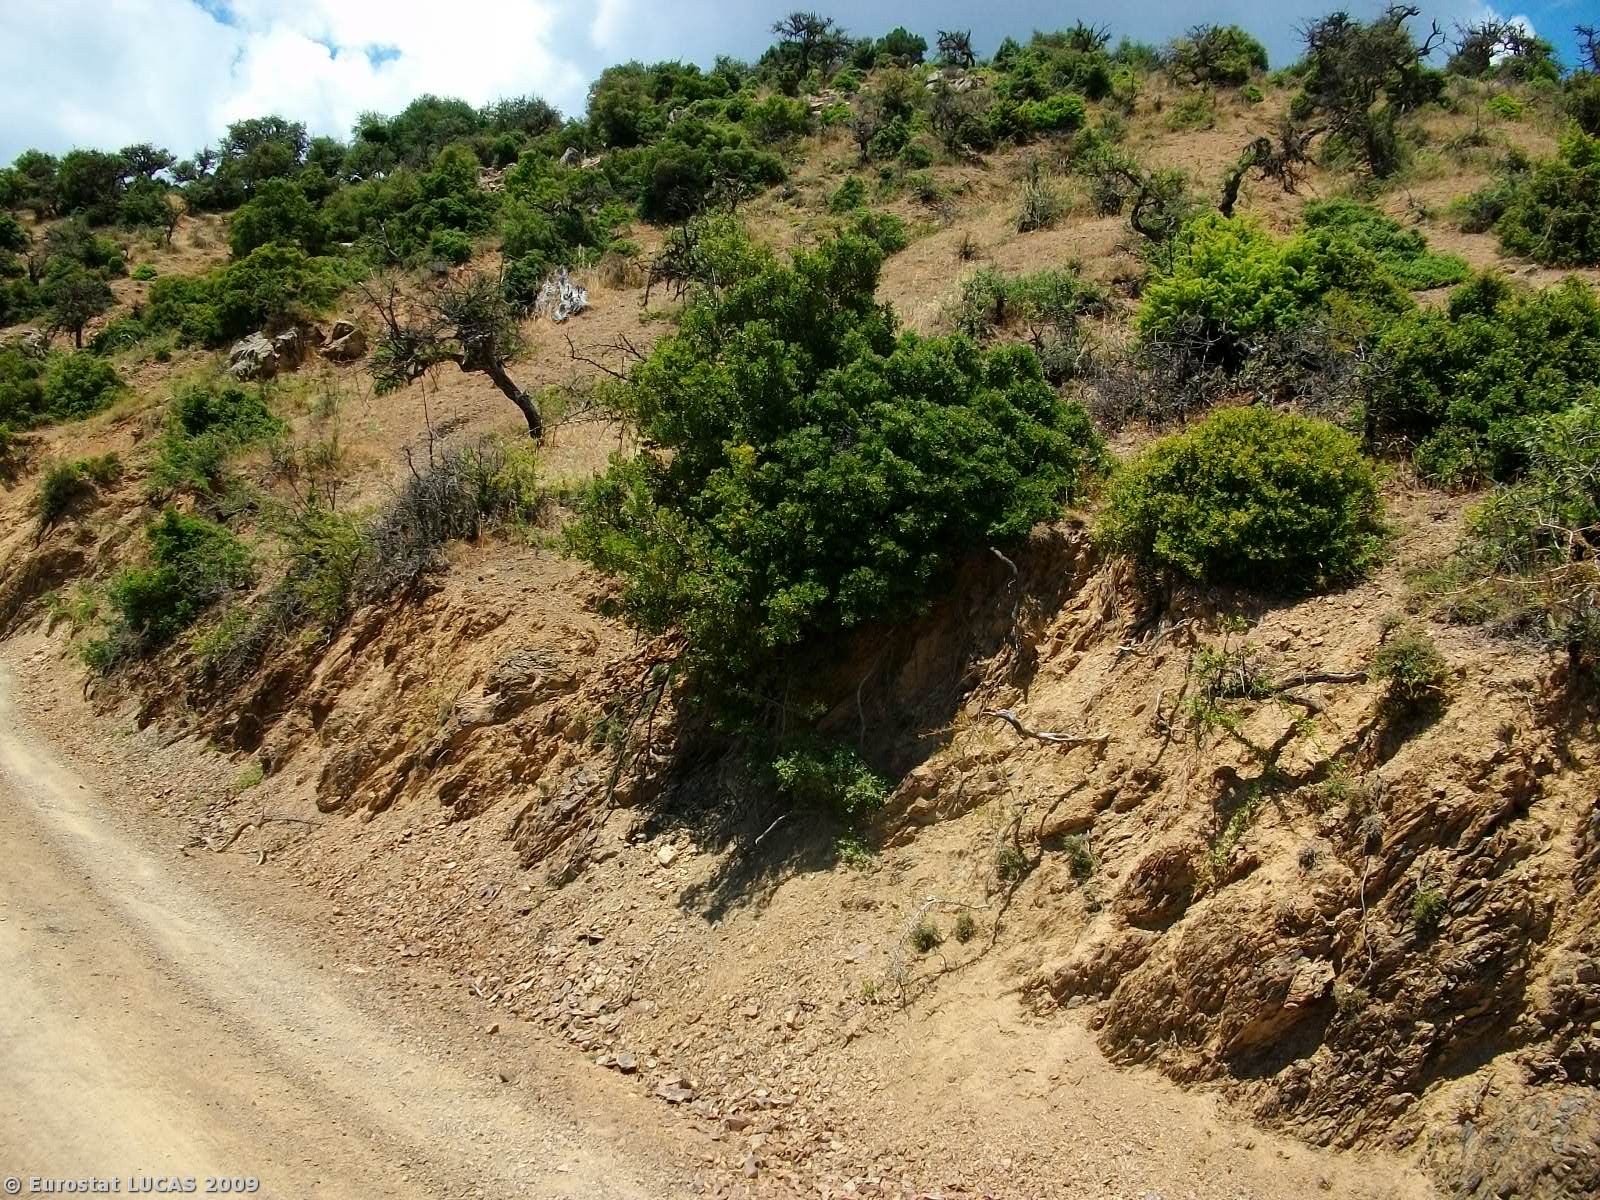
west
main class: Shrubland
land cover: Shrubland with sparse tree cover
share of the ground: 50 - 75 %
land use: Agriculture (excluding fallow land and kitchen gardens)
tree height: < 5 m
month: July
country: GR
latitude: 38.4660
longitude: 22.1560
